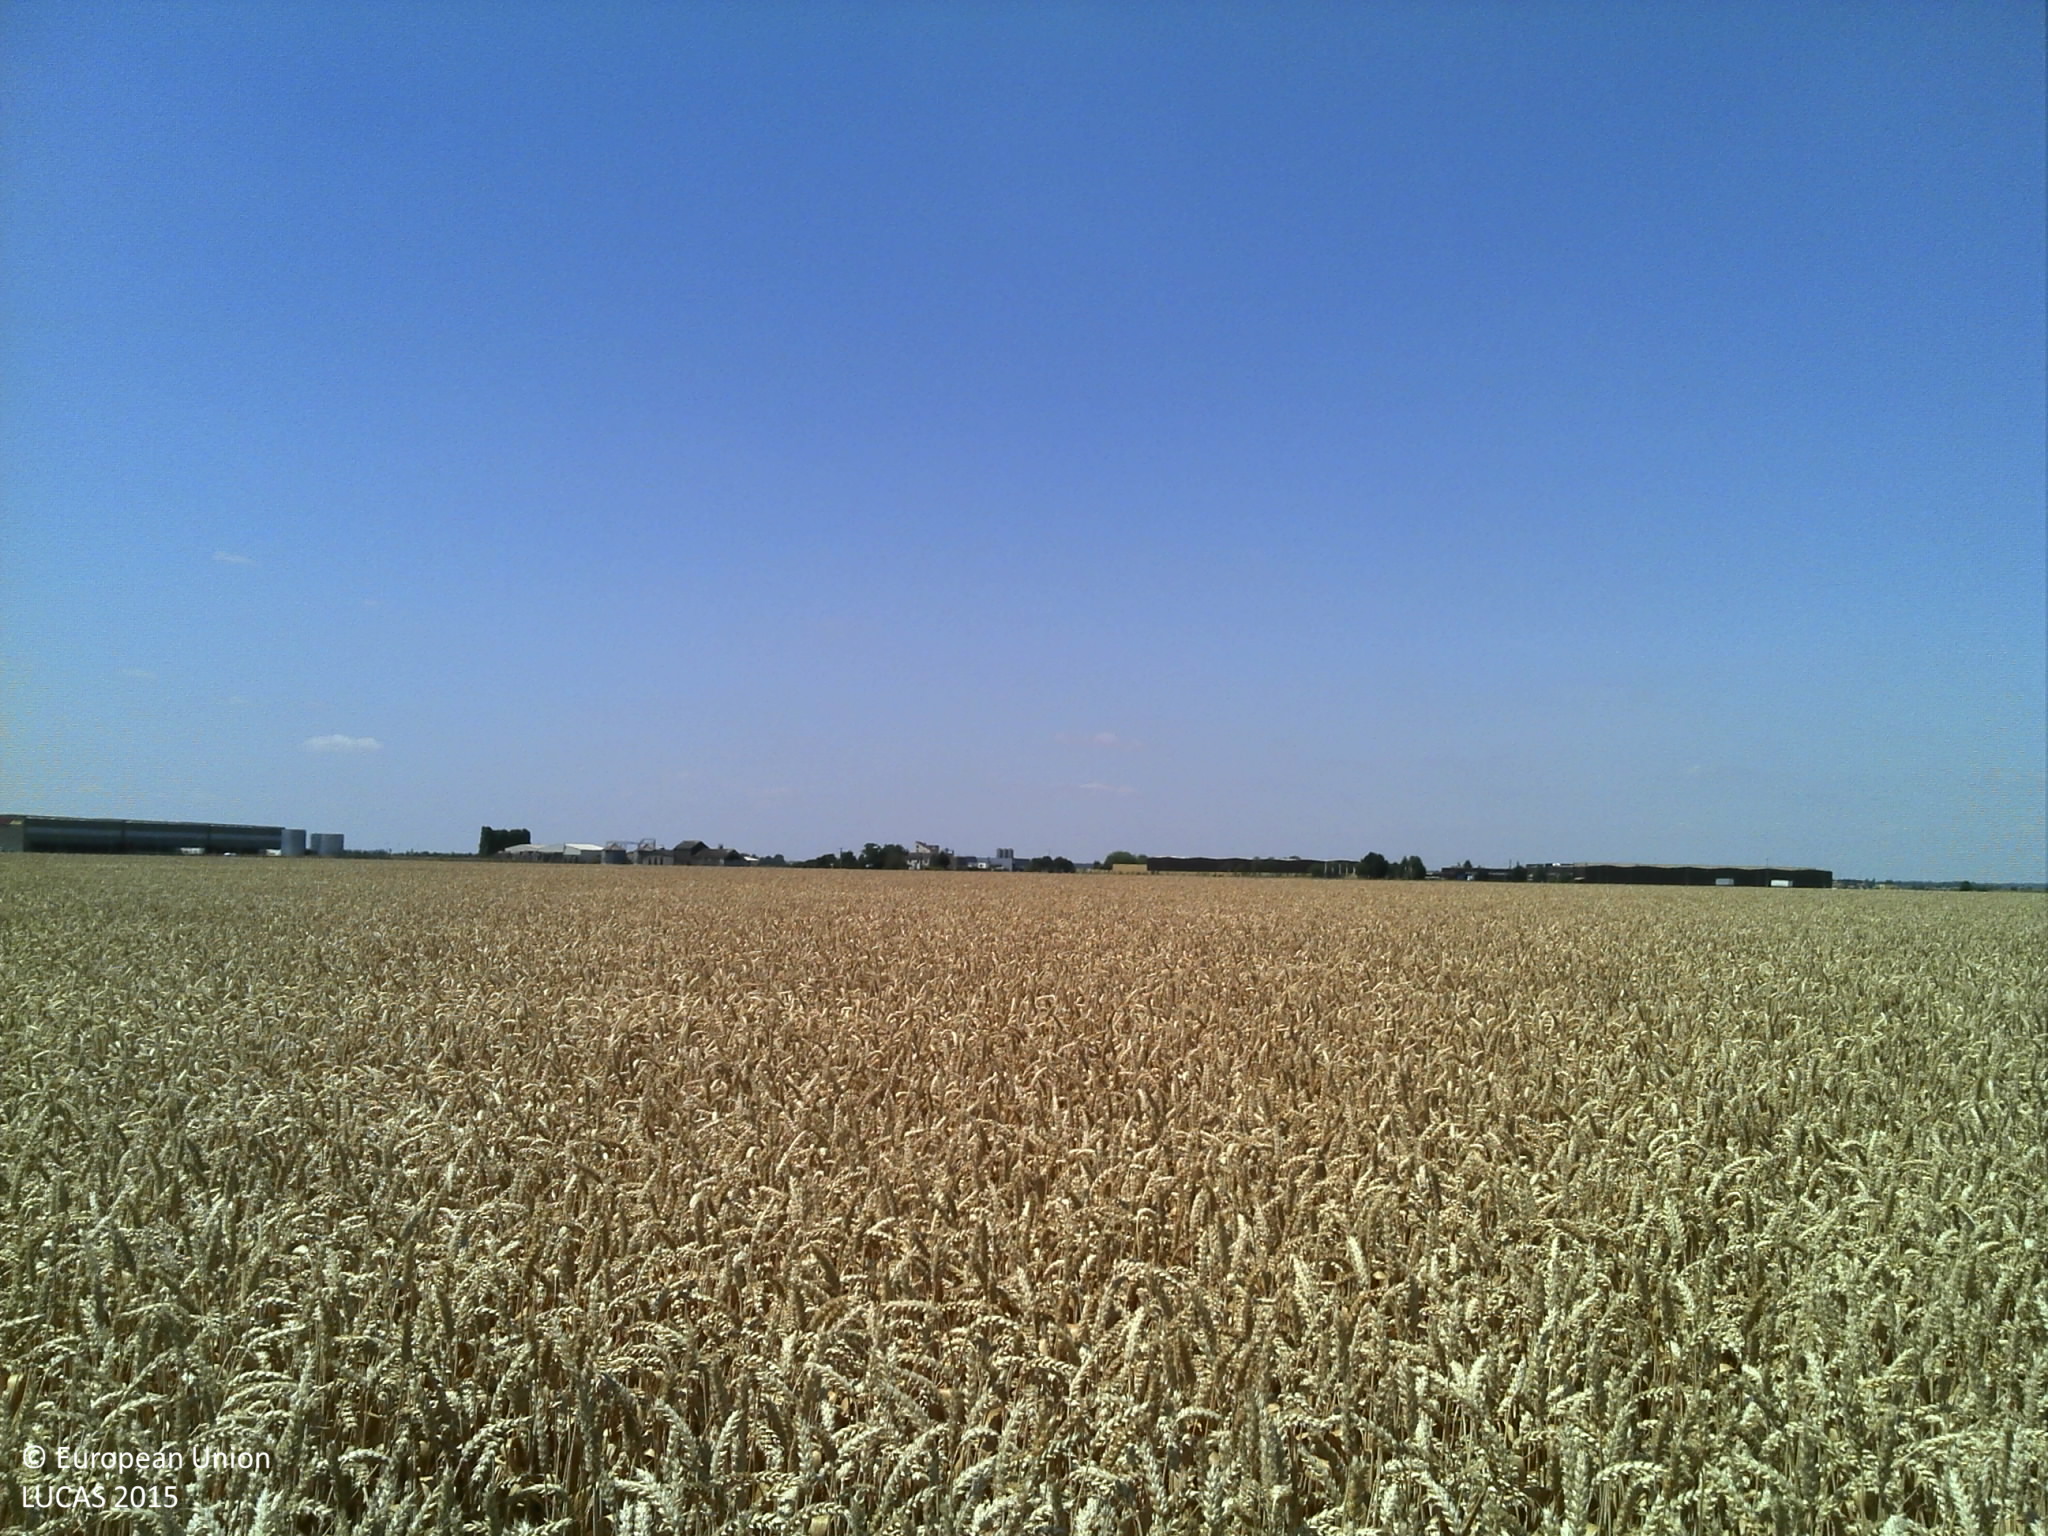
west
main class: Cropland
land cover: Common wheat
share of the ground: > 75 %
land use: Agriculture (excluding fallow land and kitchen gardens)
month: July
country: FR
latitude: 48.4526
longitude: 1.9412
